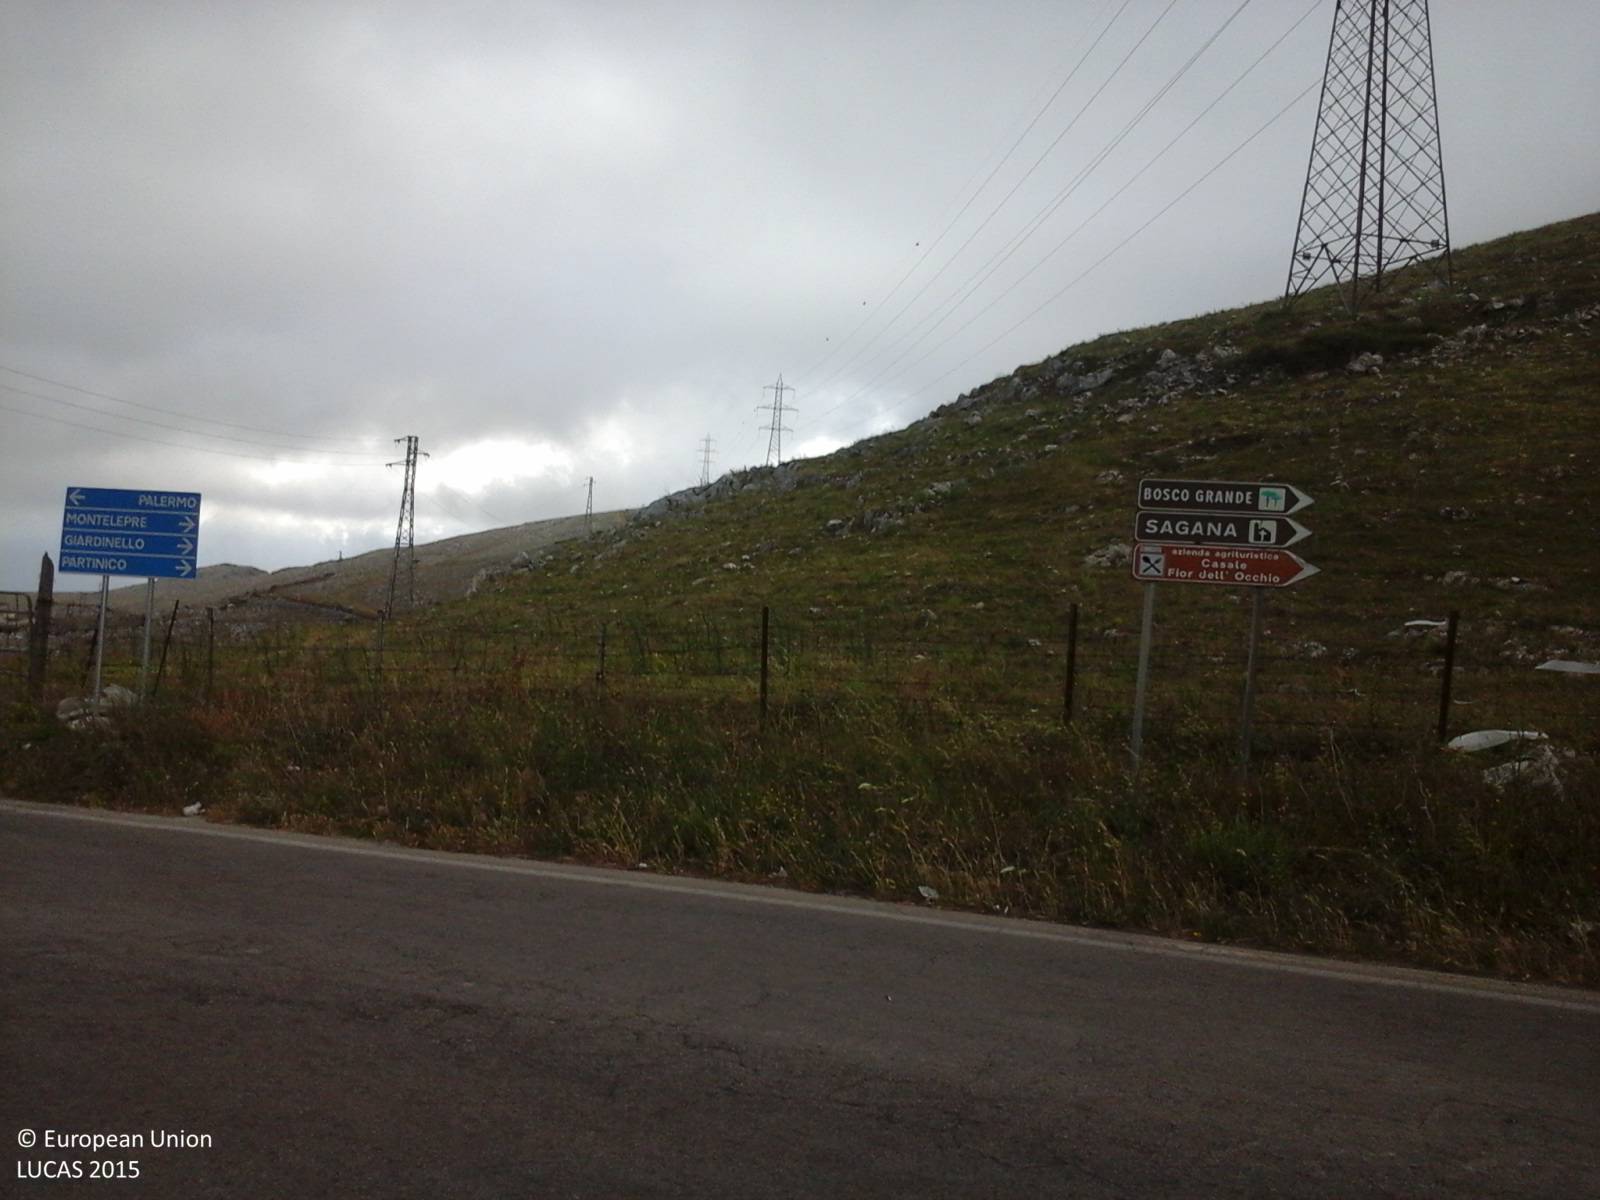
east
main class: Grassland
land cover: Grassland without tree/shrub cover
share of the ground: > 75 %
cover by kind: herbaceous plants 100 %
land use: Agriculture (excluding fallow land and kitchen gardens)
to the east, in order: Grassland without tree/shrub cover; Rocks and stones; Grassland without tree/shrub cover
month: June
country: IT
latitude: 38.1279
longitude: 13.2513
